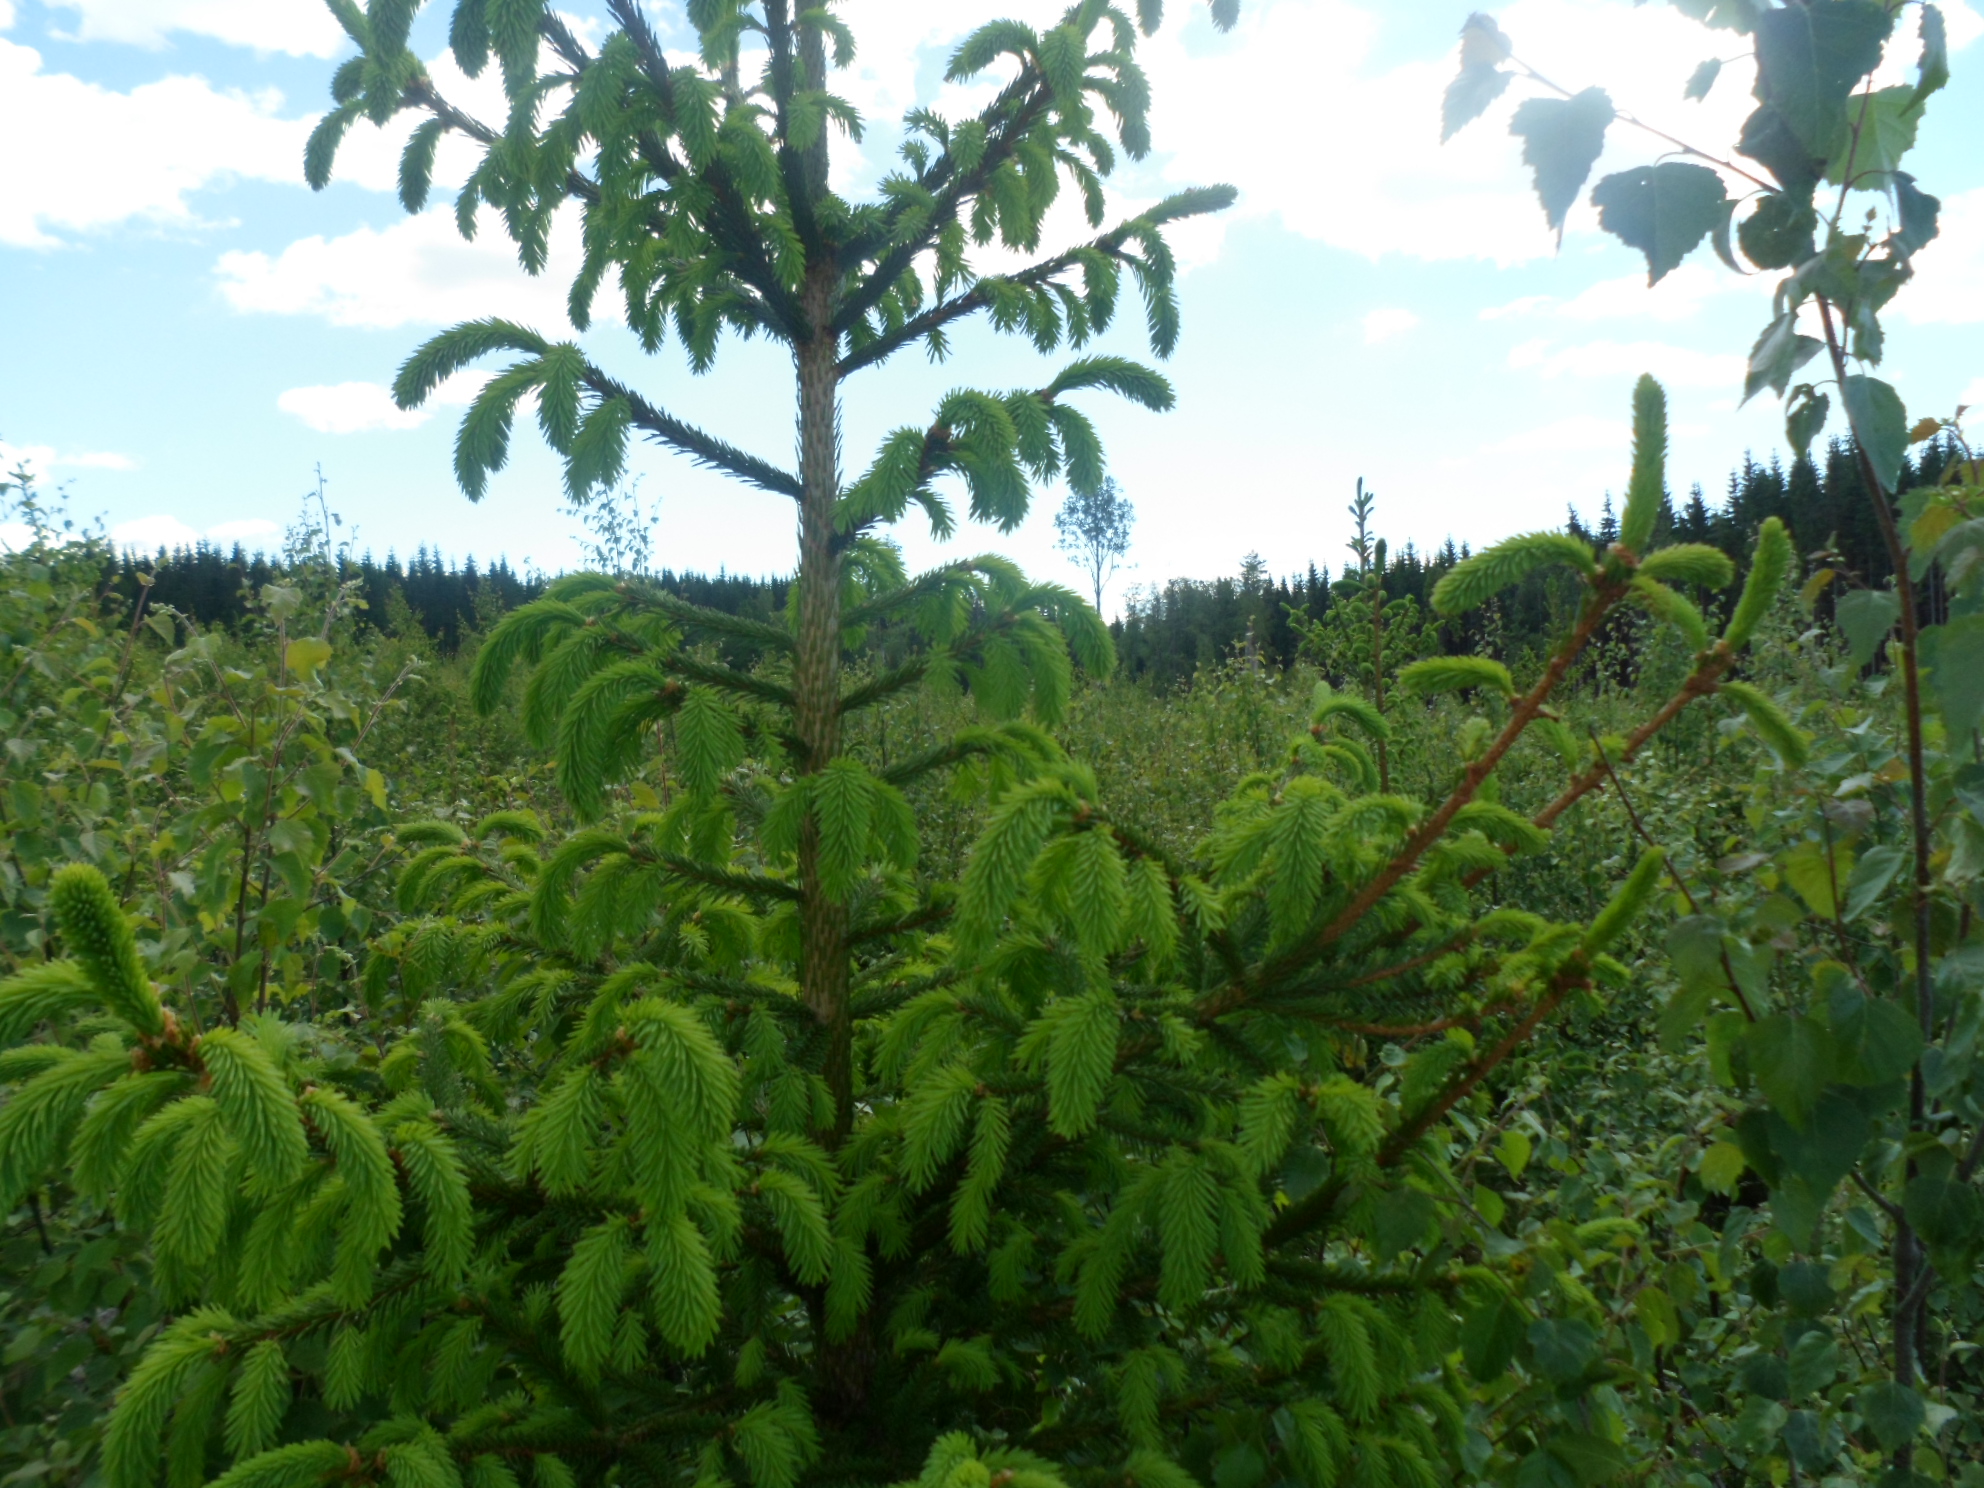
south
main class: Woodland
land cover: Spruce dominated mixed woodland
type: boreal forest
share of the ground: > 75 %
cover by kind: broadleaved forest trees 45 %, coniferous forest trees 35 %, herbaceous plants 15 %, shrubs 5 %
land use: Forestry
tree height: < 5 m
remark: Clear cut
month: July
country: SE
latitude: 57.4267
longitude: 14.4090
